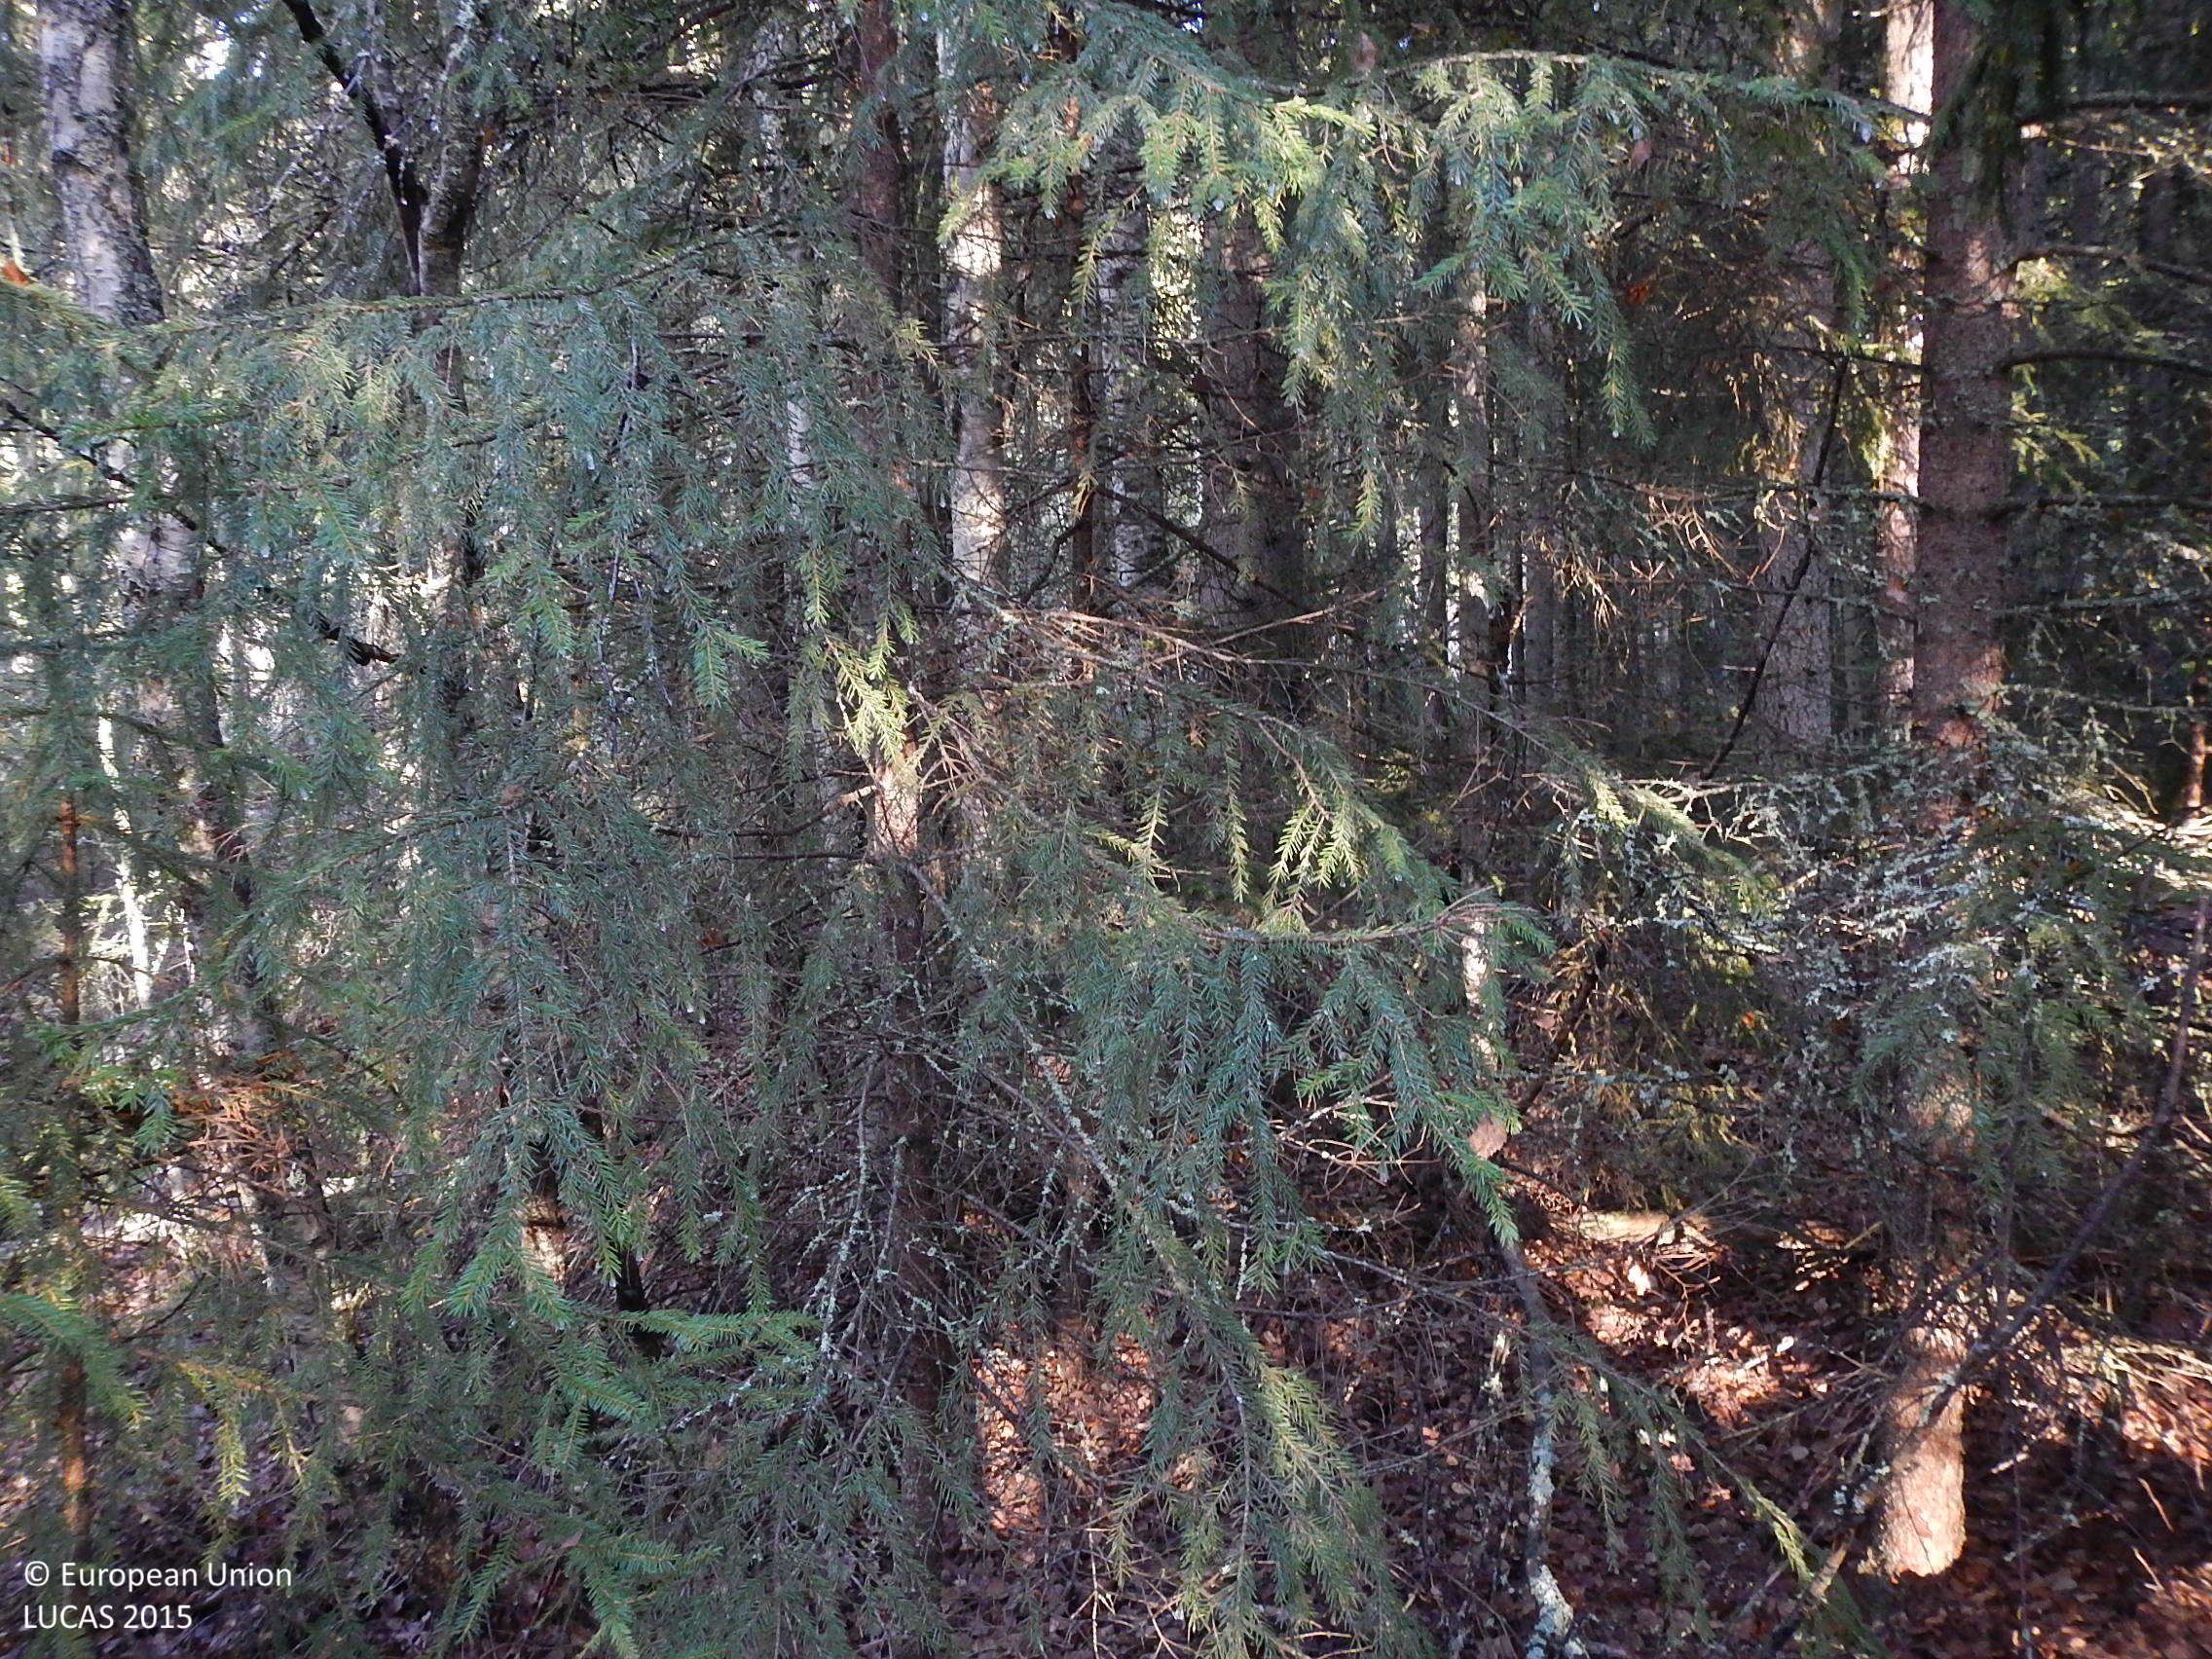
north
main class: Woodland
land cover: Spruce dominated mixed woodland
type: boreal forest
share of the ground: 50 - 75 %
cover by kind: coniferous forest trees 40 %, broadleaved forest trees 30 %, shrubs 15 %, unconsolidated bare surface 10 %, lichens and mosses 5 %
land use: Forestry
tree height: > 5 m
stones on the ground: < 10 %
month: November
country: SE
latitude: 61.5680
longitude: 16.0649
